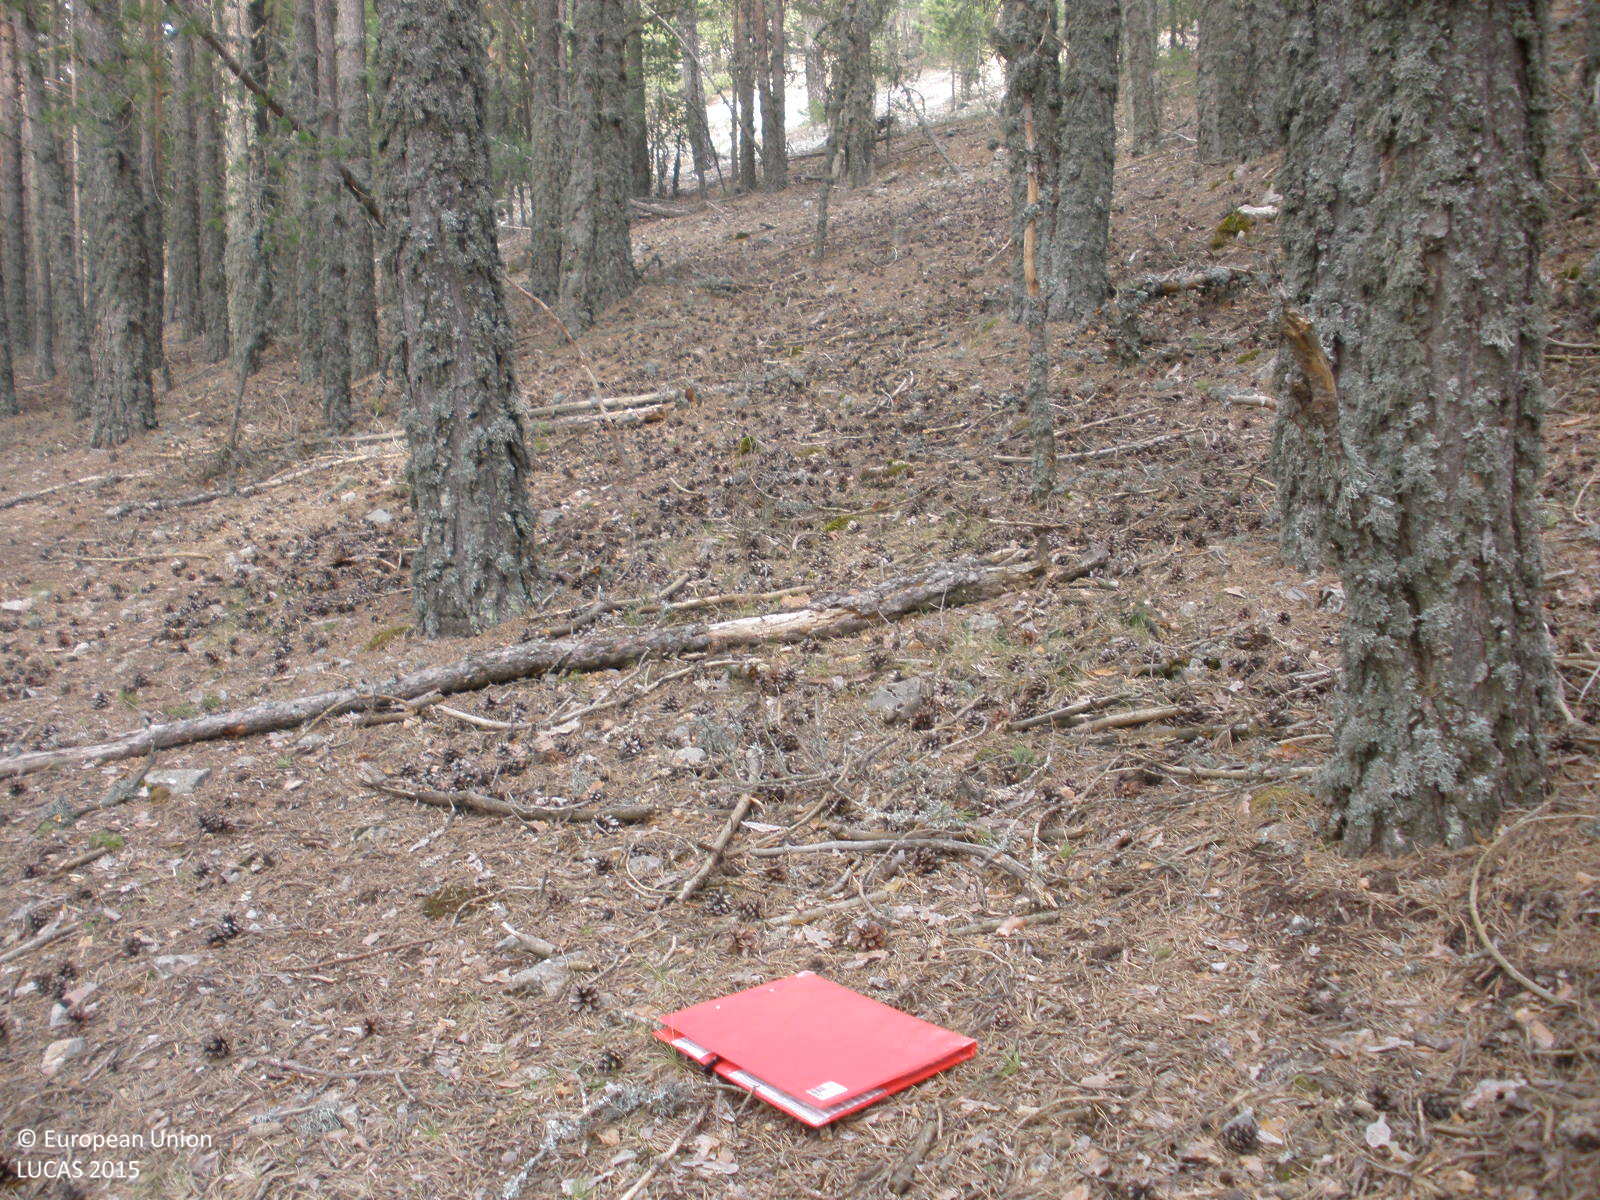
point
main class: Woodland
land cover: Pine dominated coniferous woodland
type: coniferous forest of the mediterranean region
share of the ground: > 75 %
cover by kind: coniferous forest trees 90 %, consolidated bare surface 10 %
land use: Semi-natural and natural areas not in use
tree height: > 5 m
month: April
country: ES
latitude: 40.1183
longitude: -1.0255
